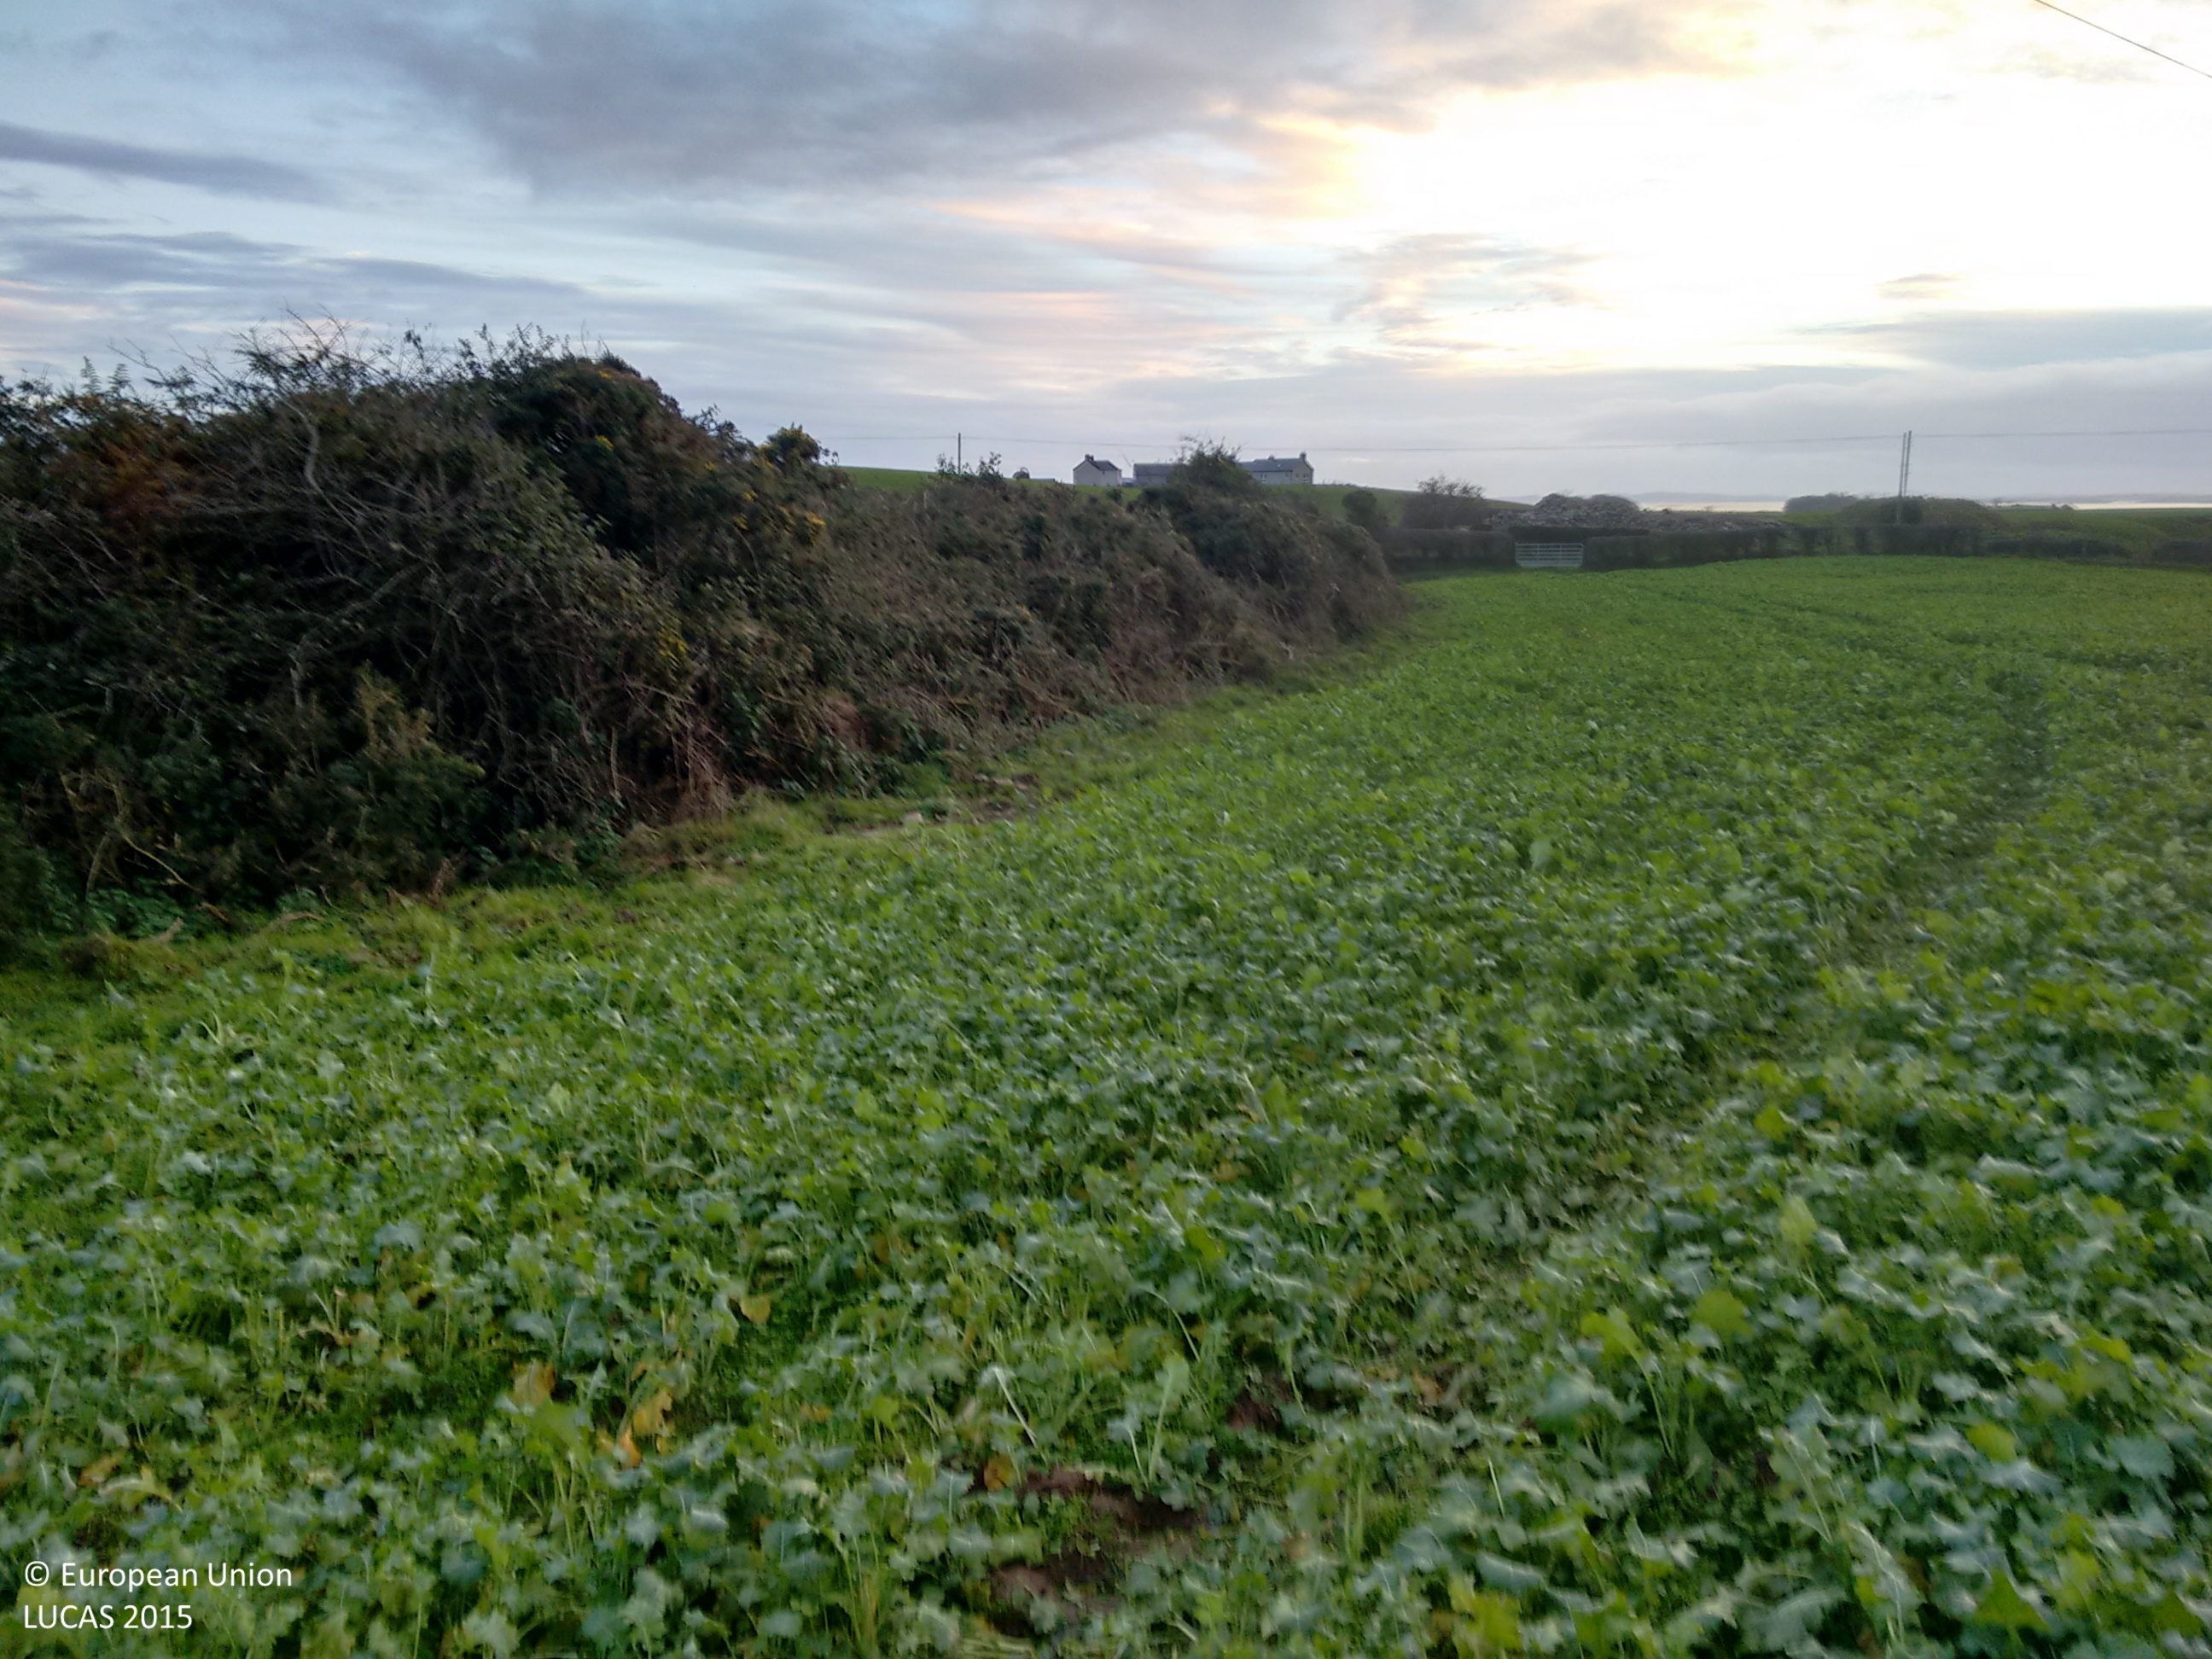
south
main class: Cropland
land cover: Other fresh vegetables
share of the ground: > 75 %
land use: Agriculture (excluding fallow land and kitchen gardens)
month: November
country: GB
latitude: 54.5493
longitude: -5.5737
